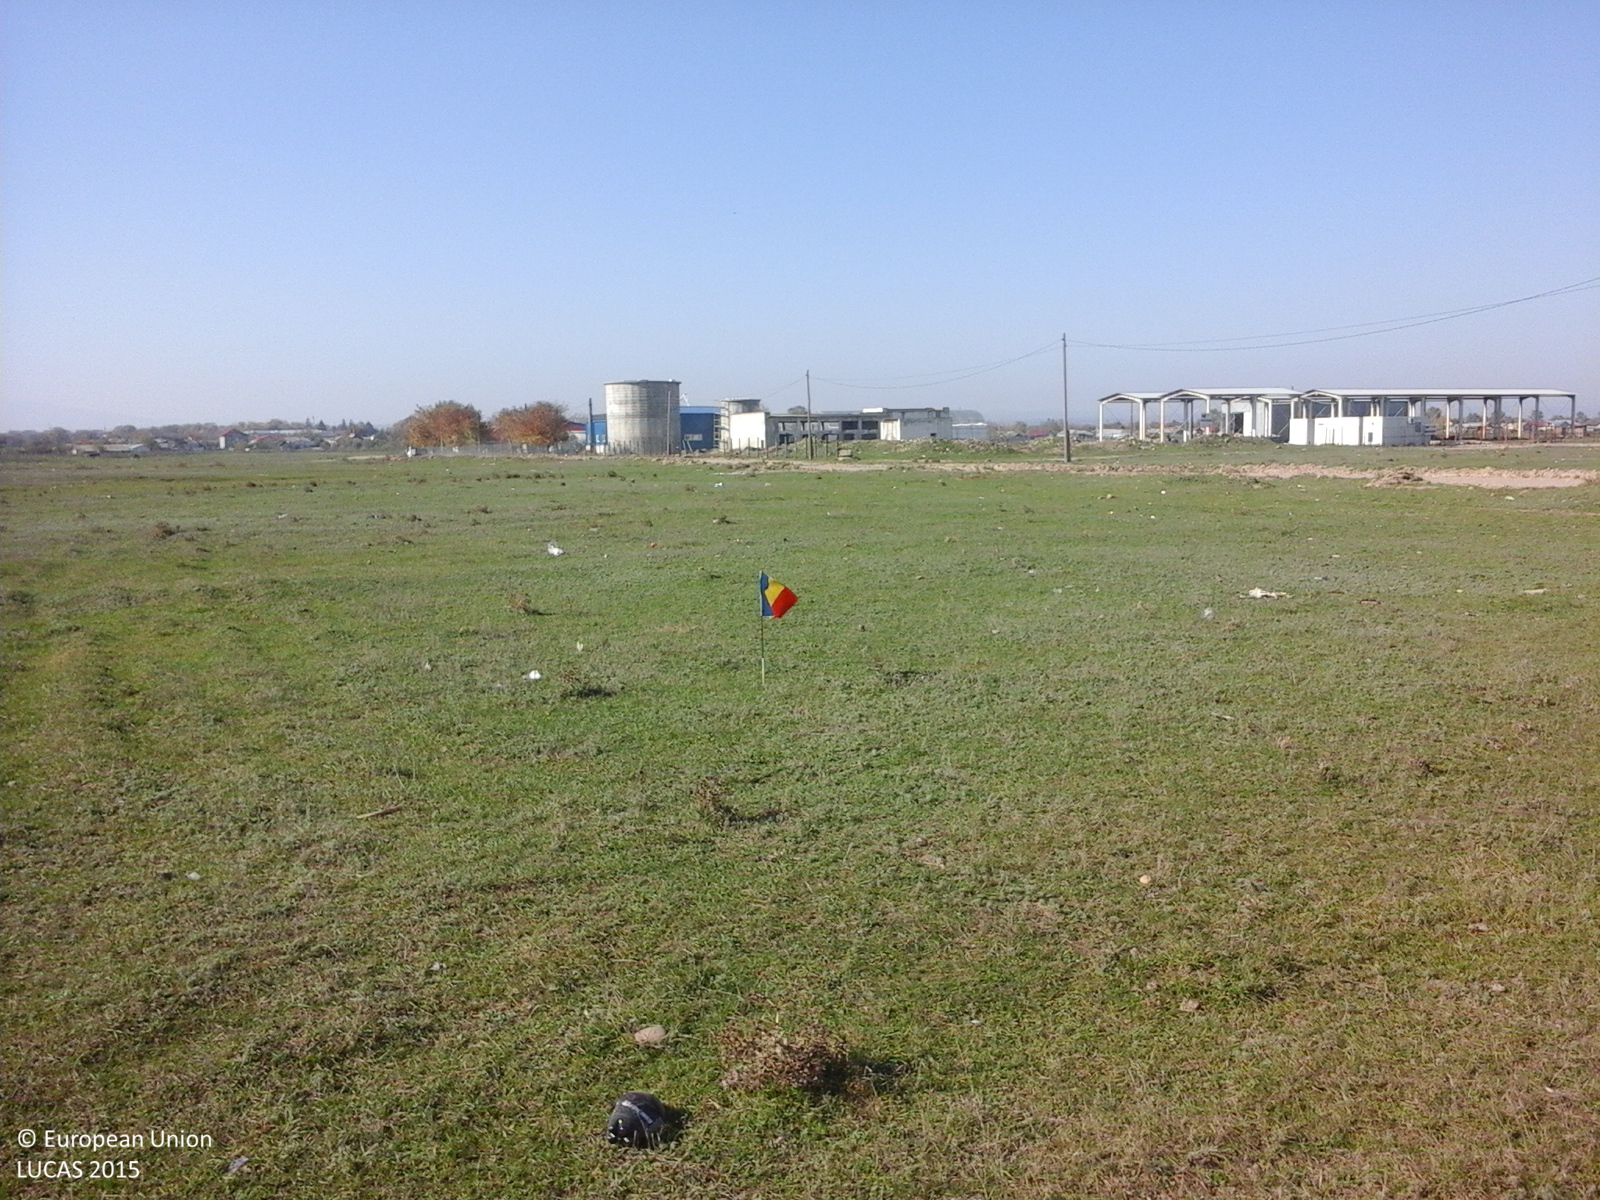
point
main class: Grassland
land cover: Grassland without tree/shrub cover
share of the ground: > 75 %
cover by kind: herbaceous plants 100 %
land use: Agriculture (excluding fallow land and kitchen gardens)
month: October
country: RO
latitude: 45.8752
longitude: 27.2460
